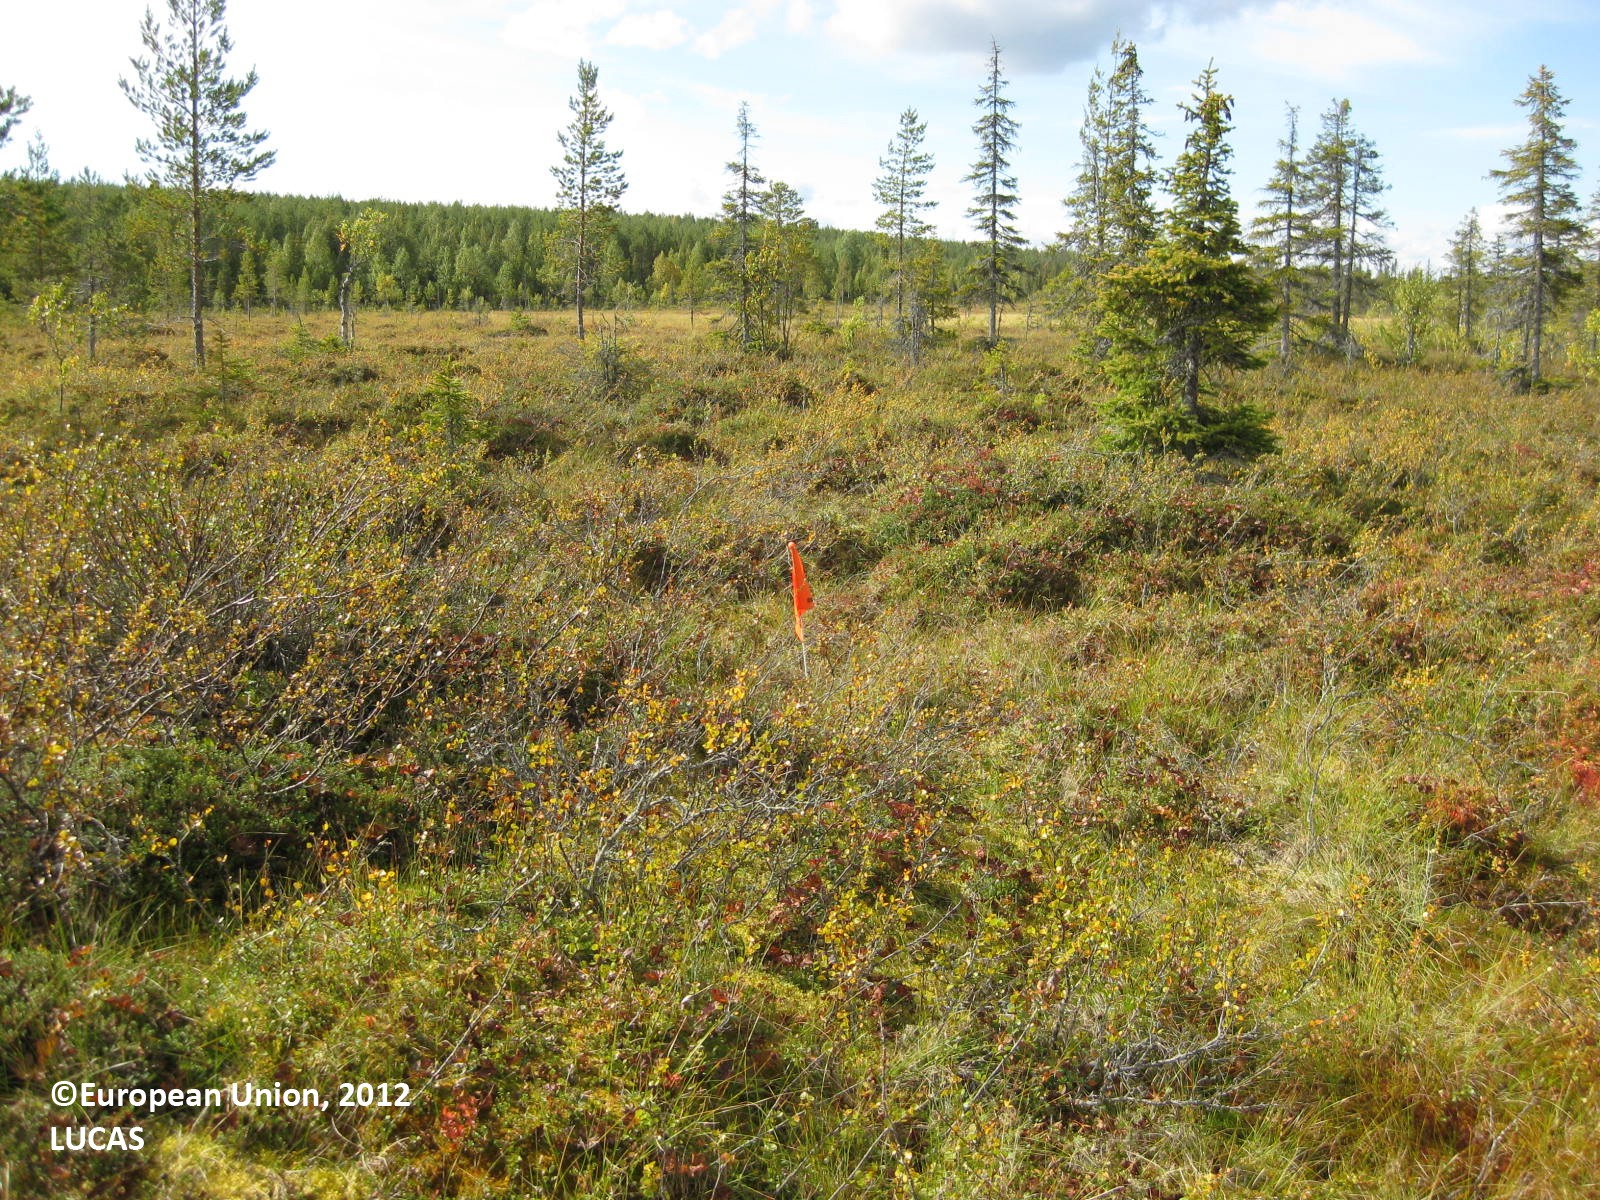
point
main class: Woodland
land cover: Other coniferous woodland
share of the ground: 10 - 25 %
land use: Semi-natural and natural areas not in use
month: August
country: FI
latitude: 66.1249
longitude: 29.8876
